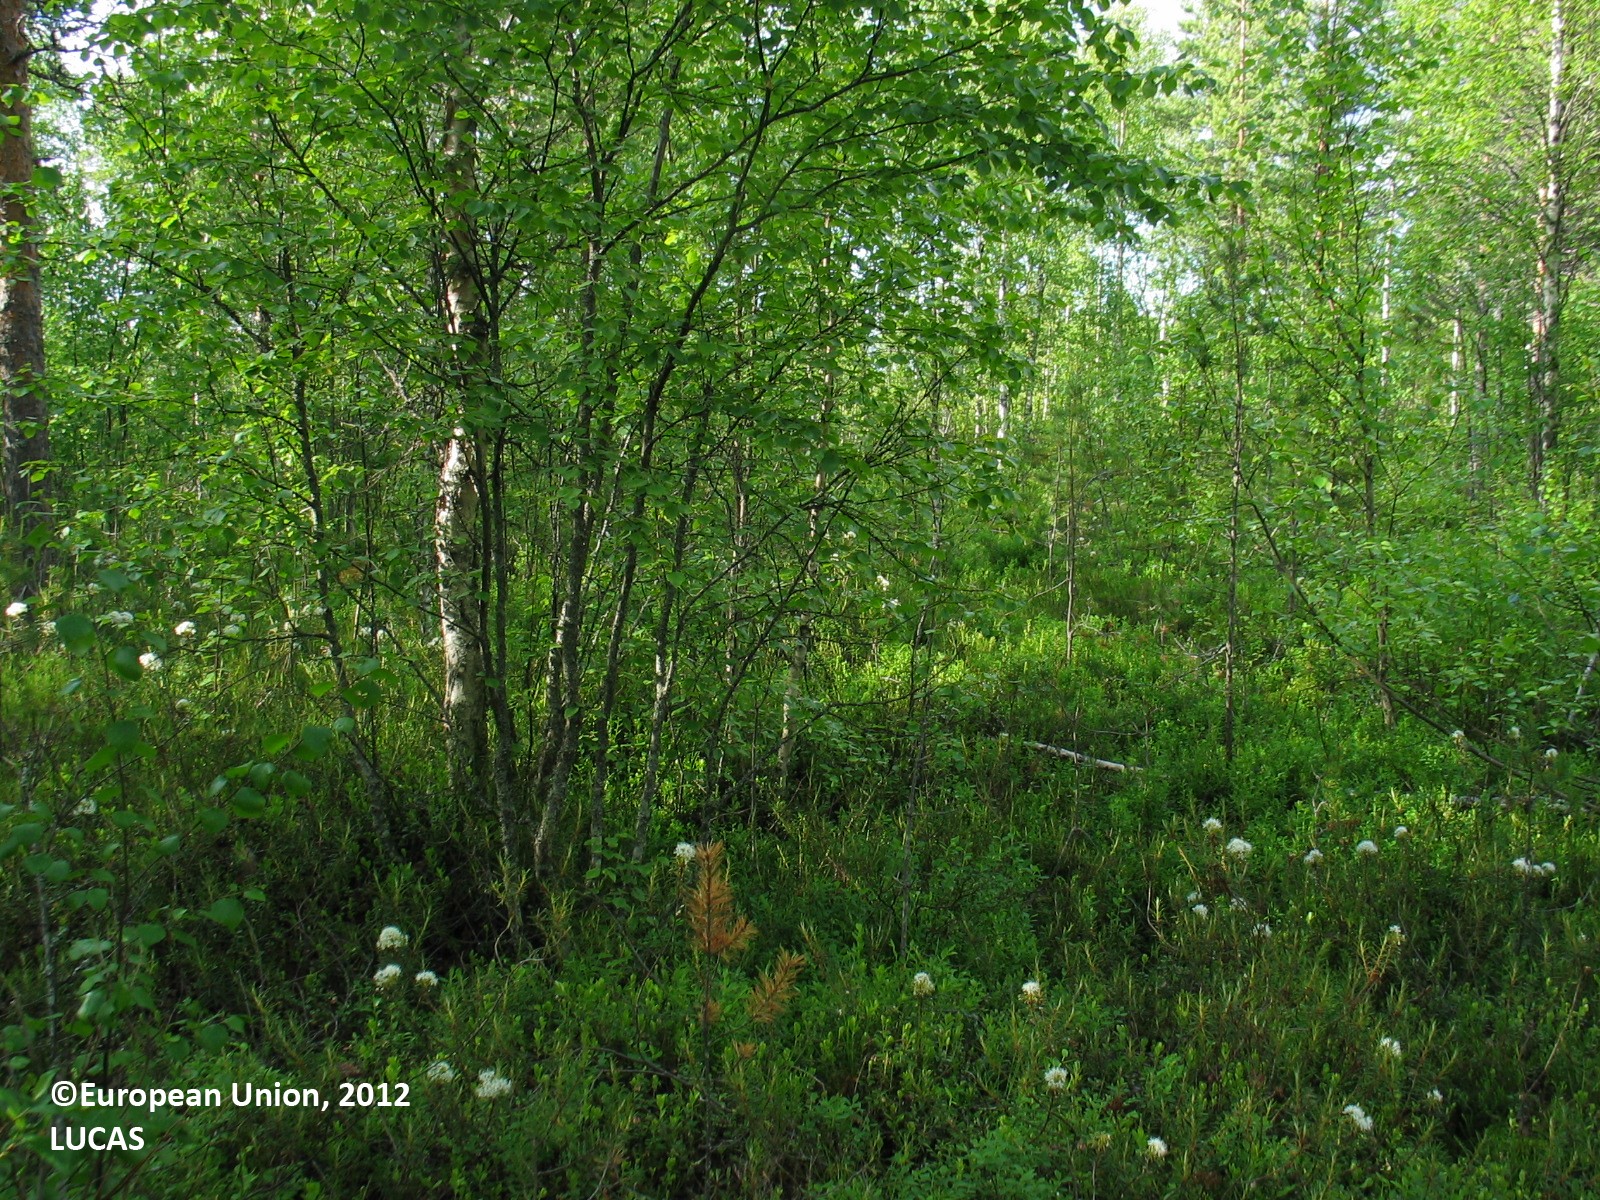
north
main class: Woodland
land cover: Pine dominated mixed woodland
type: boreal forest
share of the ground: 50 - 75 %
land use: Forestry
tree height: > 5 m
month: June
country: FI
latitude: 64.8044
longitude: 26.6842
